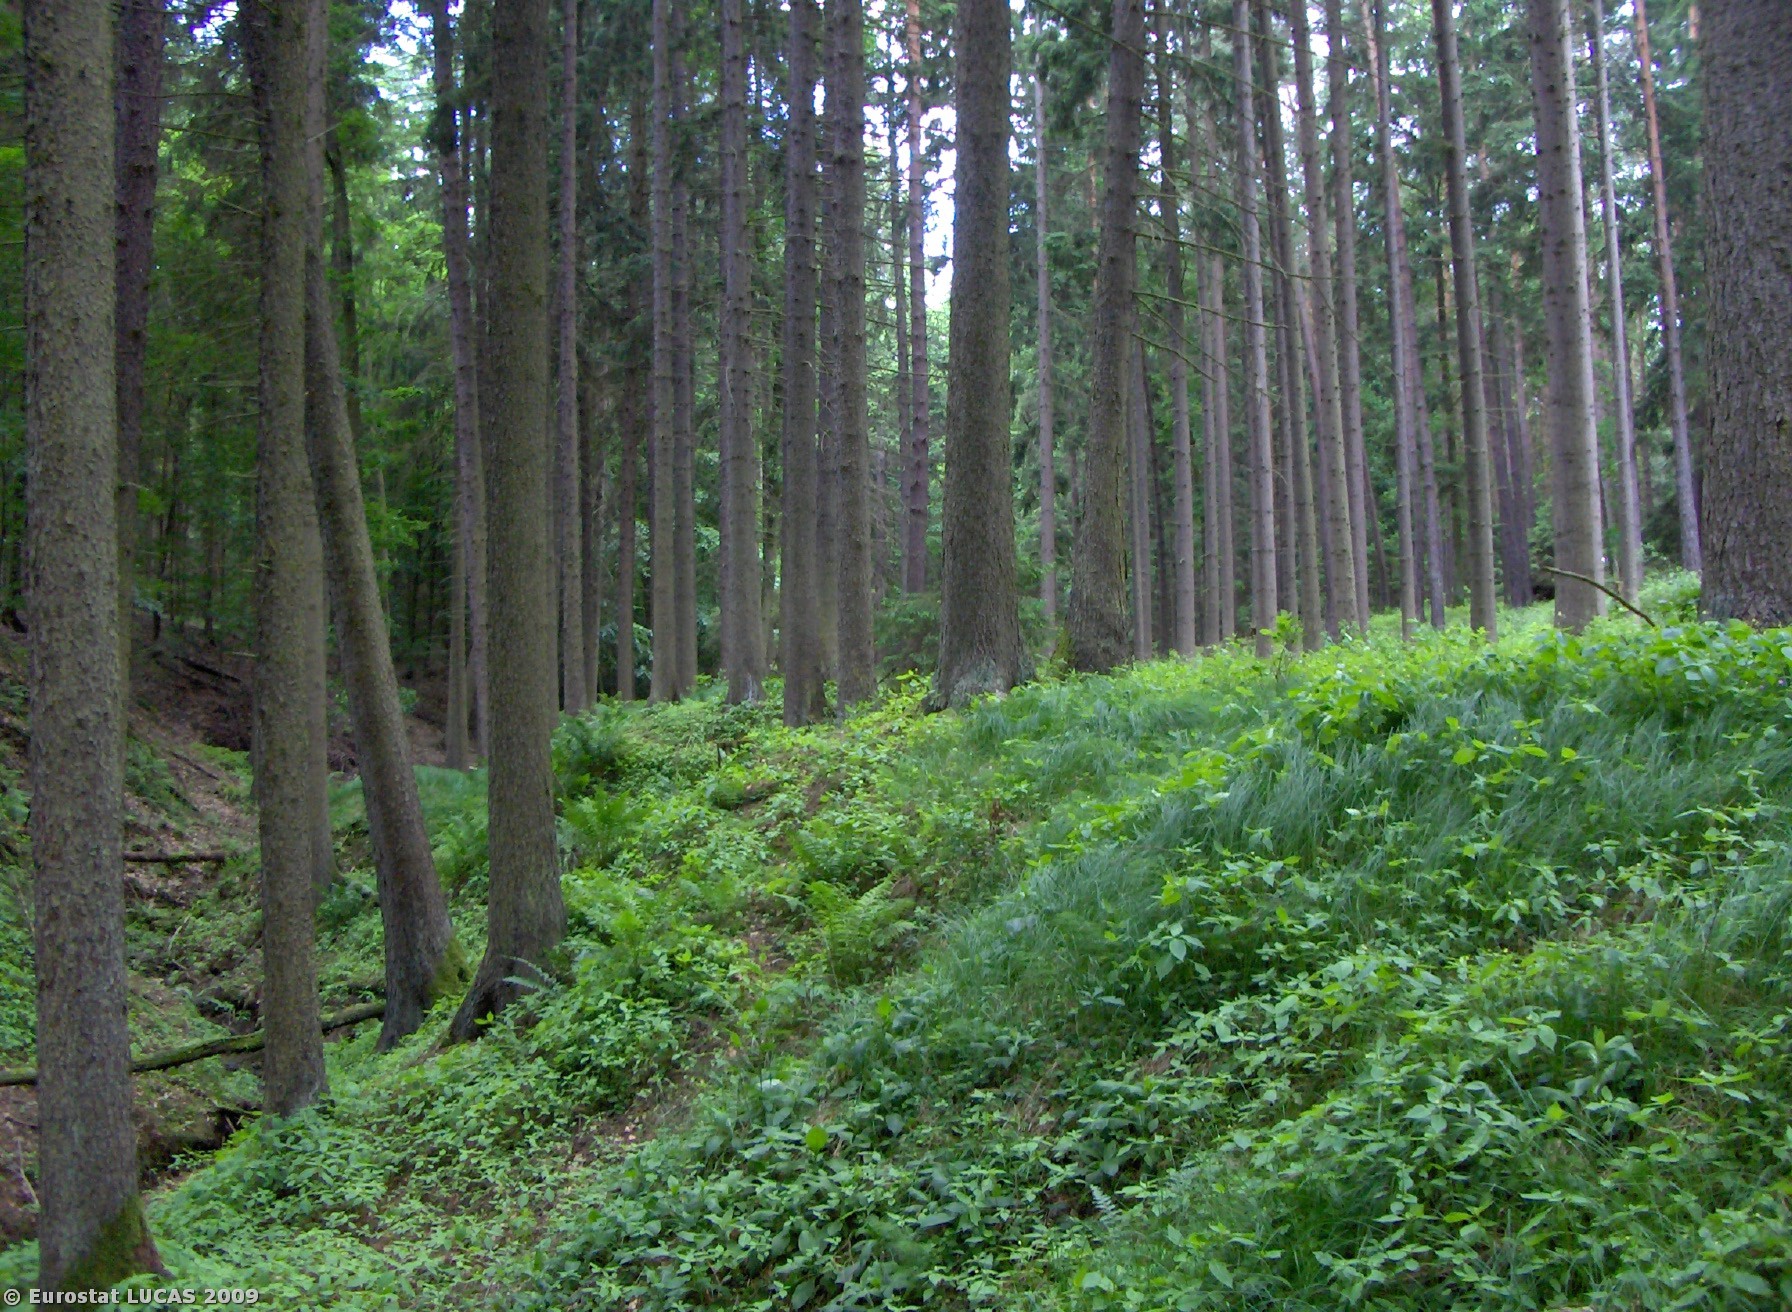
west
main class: Woodland
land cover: Coniferous woodland
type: hemiboreal forest and nemoral coniferous forest and mixed broadleaved-coniferous forest
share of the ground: > 75 %
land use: Forestry
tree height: > 5 m
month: June
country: CZ
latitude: 49.2915
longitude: 14.3322
